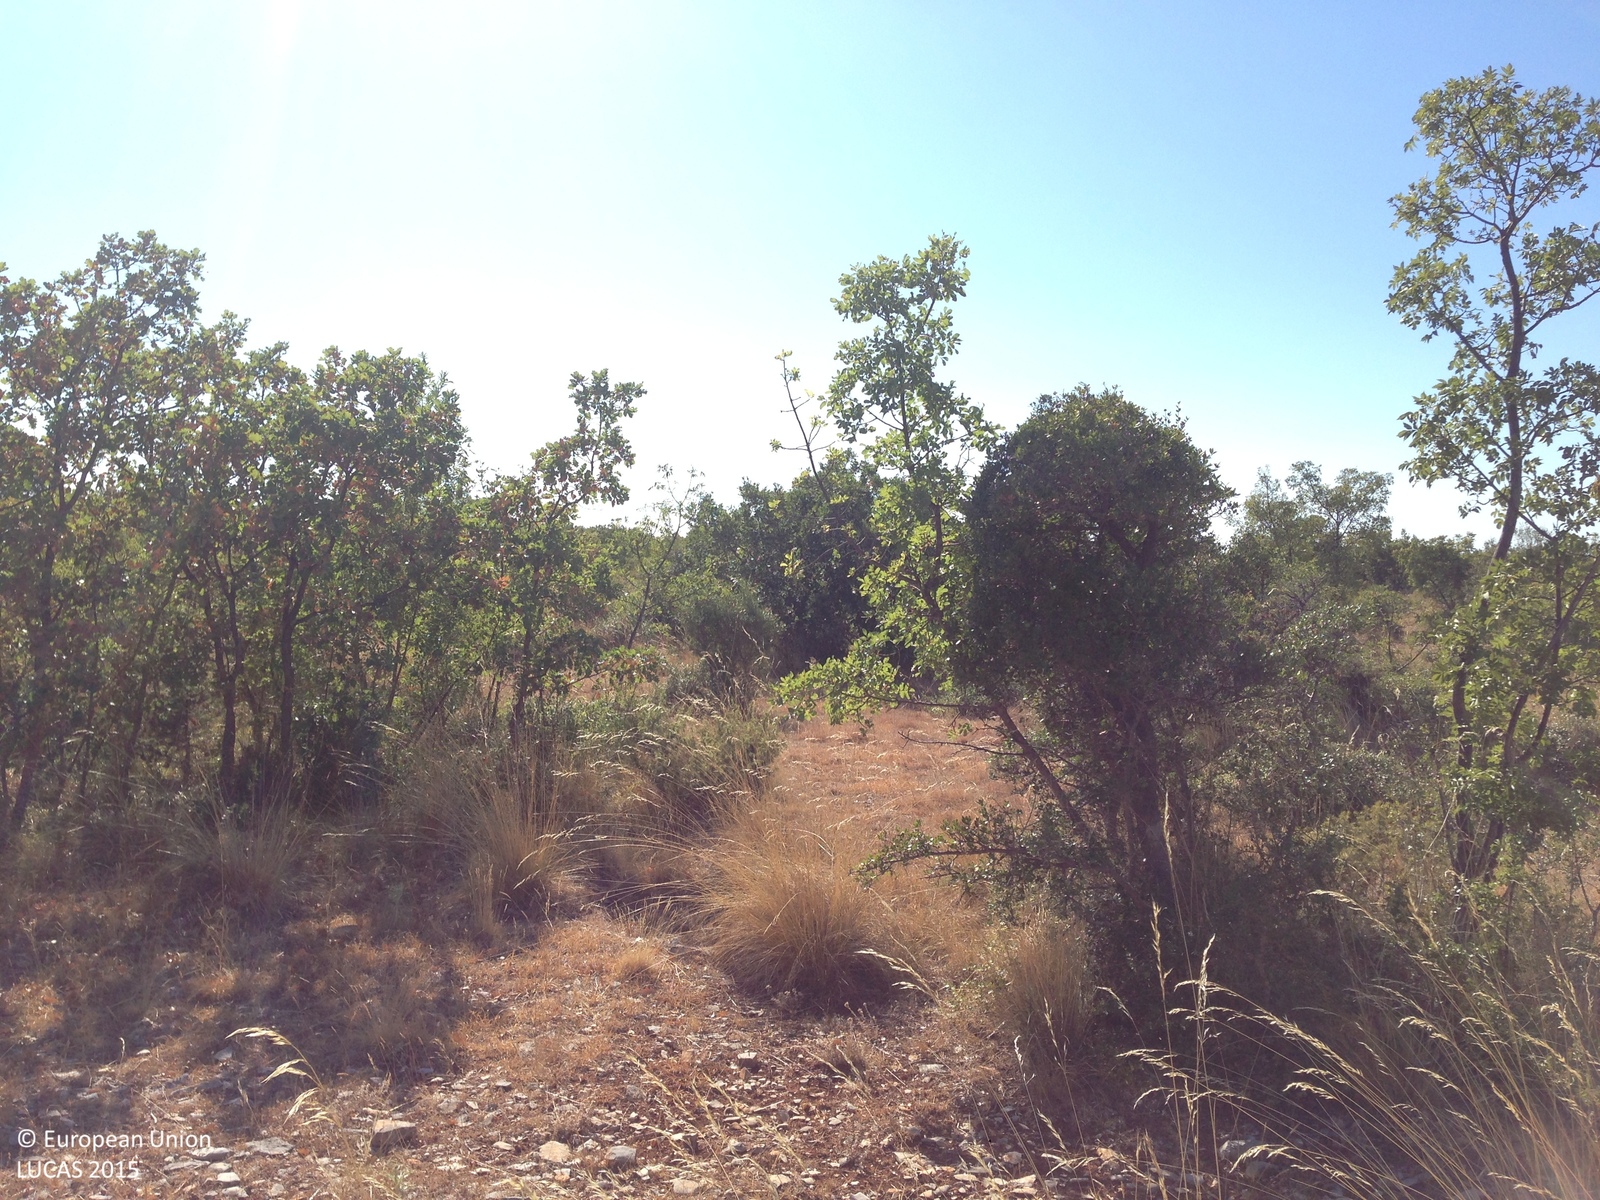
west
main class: Shrubland
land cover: Shrubland with sparse tree cover
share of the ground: 50 - 75 %
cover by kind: shrubs 65 %, herbaceous plants 15 %, unconsolidated bare surface 10 %, broadleaved forest trees 5 %, consolidated bare surface 5 %
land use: Semi-natural and natural areas not in use
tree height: < 5 m
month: July
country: HR
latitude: 44.1282
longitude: 15.5787
